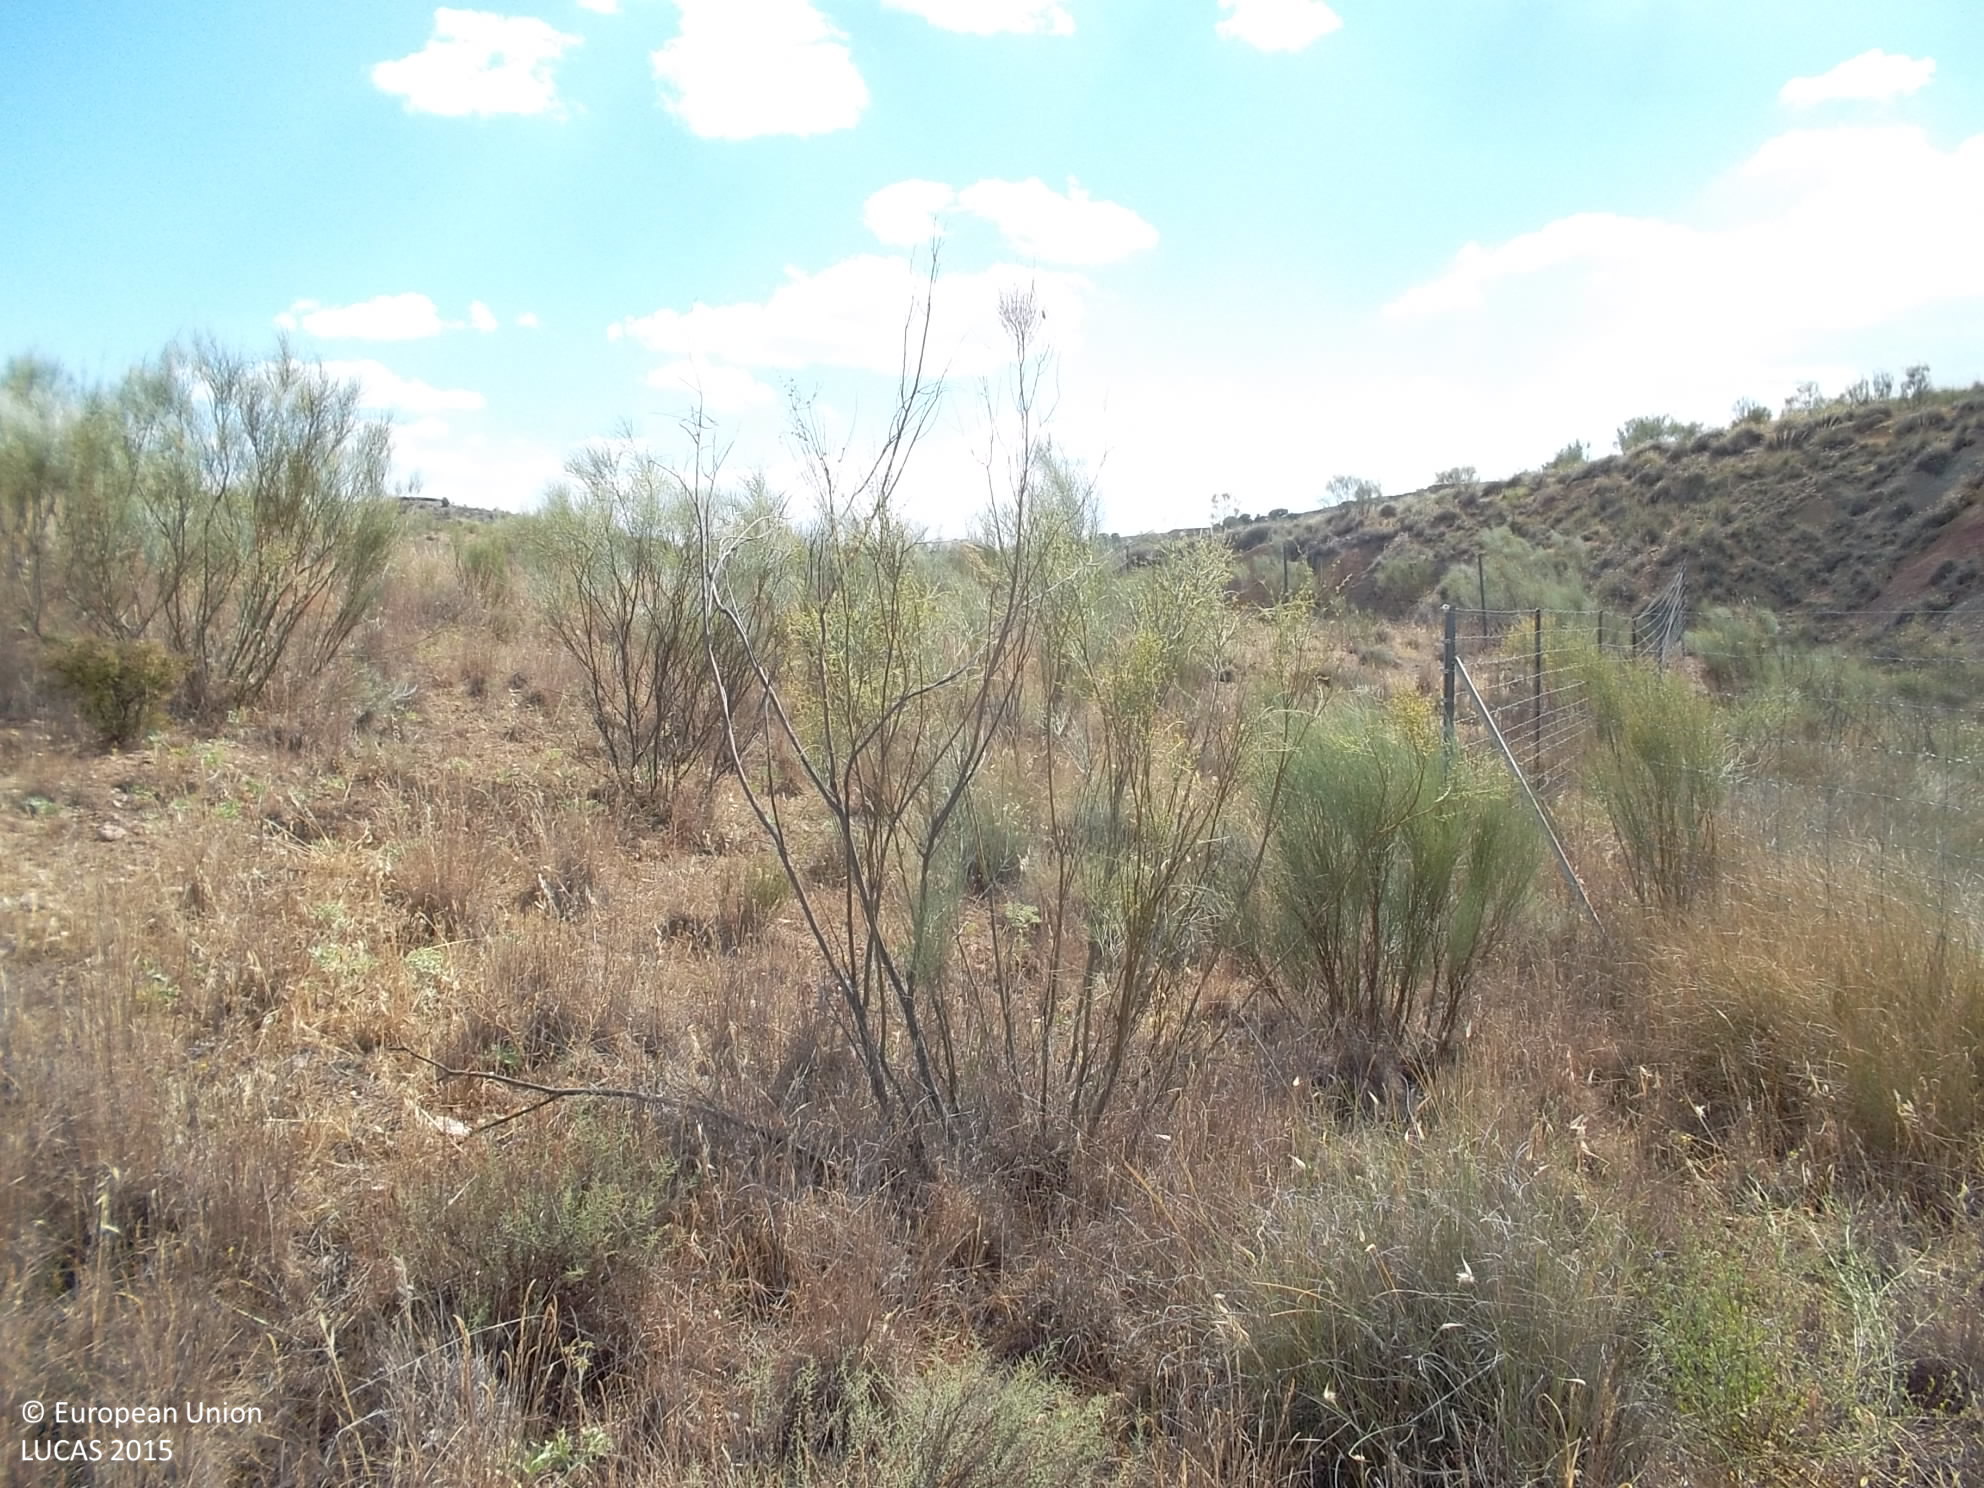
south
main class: Grassland
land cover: Grassland with sparse tree/shrub cover
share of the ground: > 75 %
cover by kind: herbaceous plants 85 %, shrubs 10 %, broadleaved forest trees 5 %
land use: Agriculture (excluding fallow land and kitchen gardens)
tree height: < 5 m
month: June
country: ES
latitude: 37.6847
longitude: -3.2041
